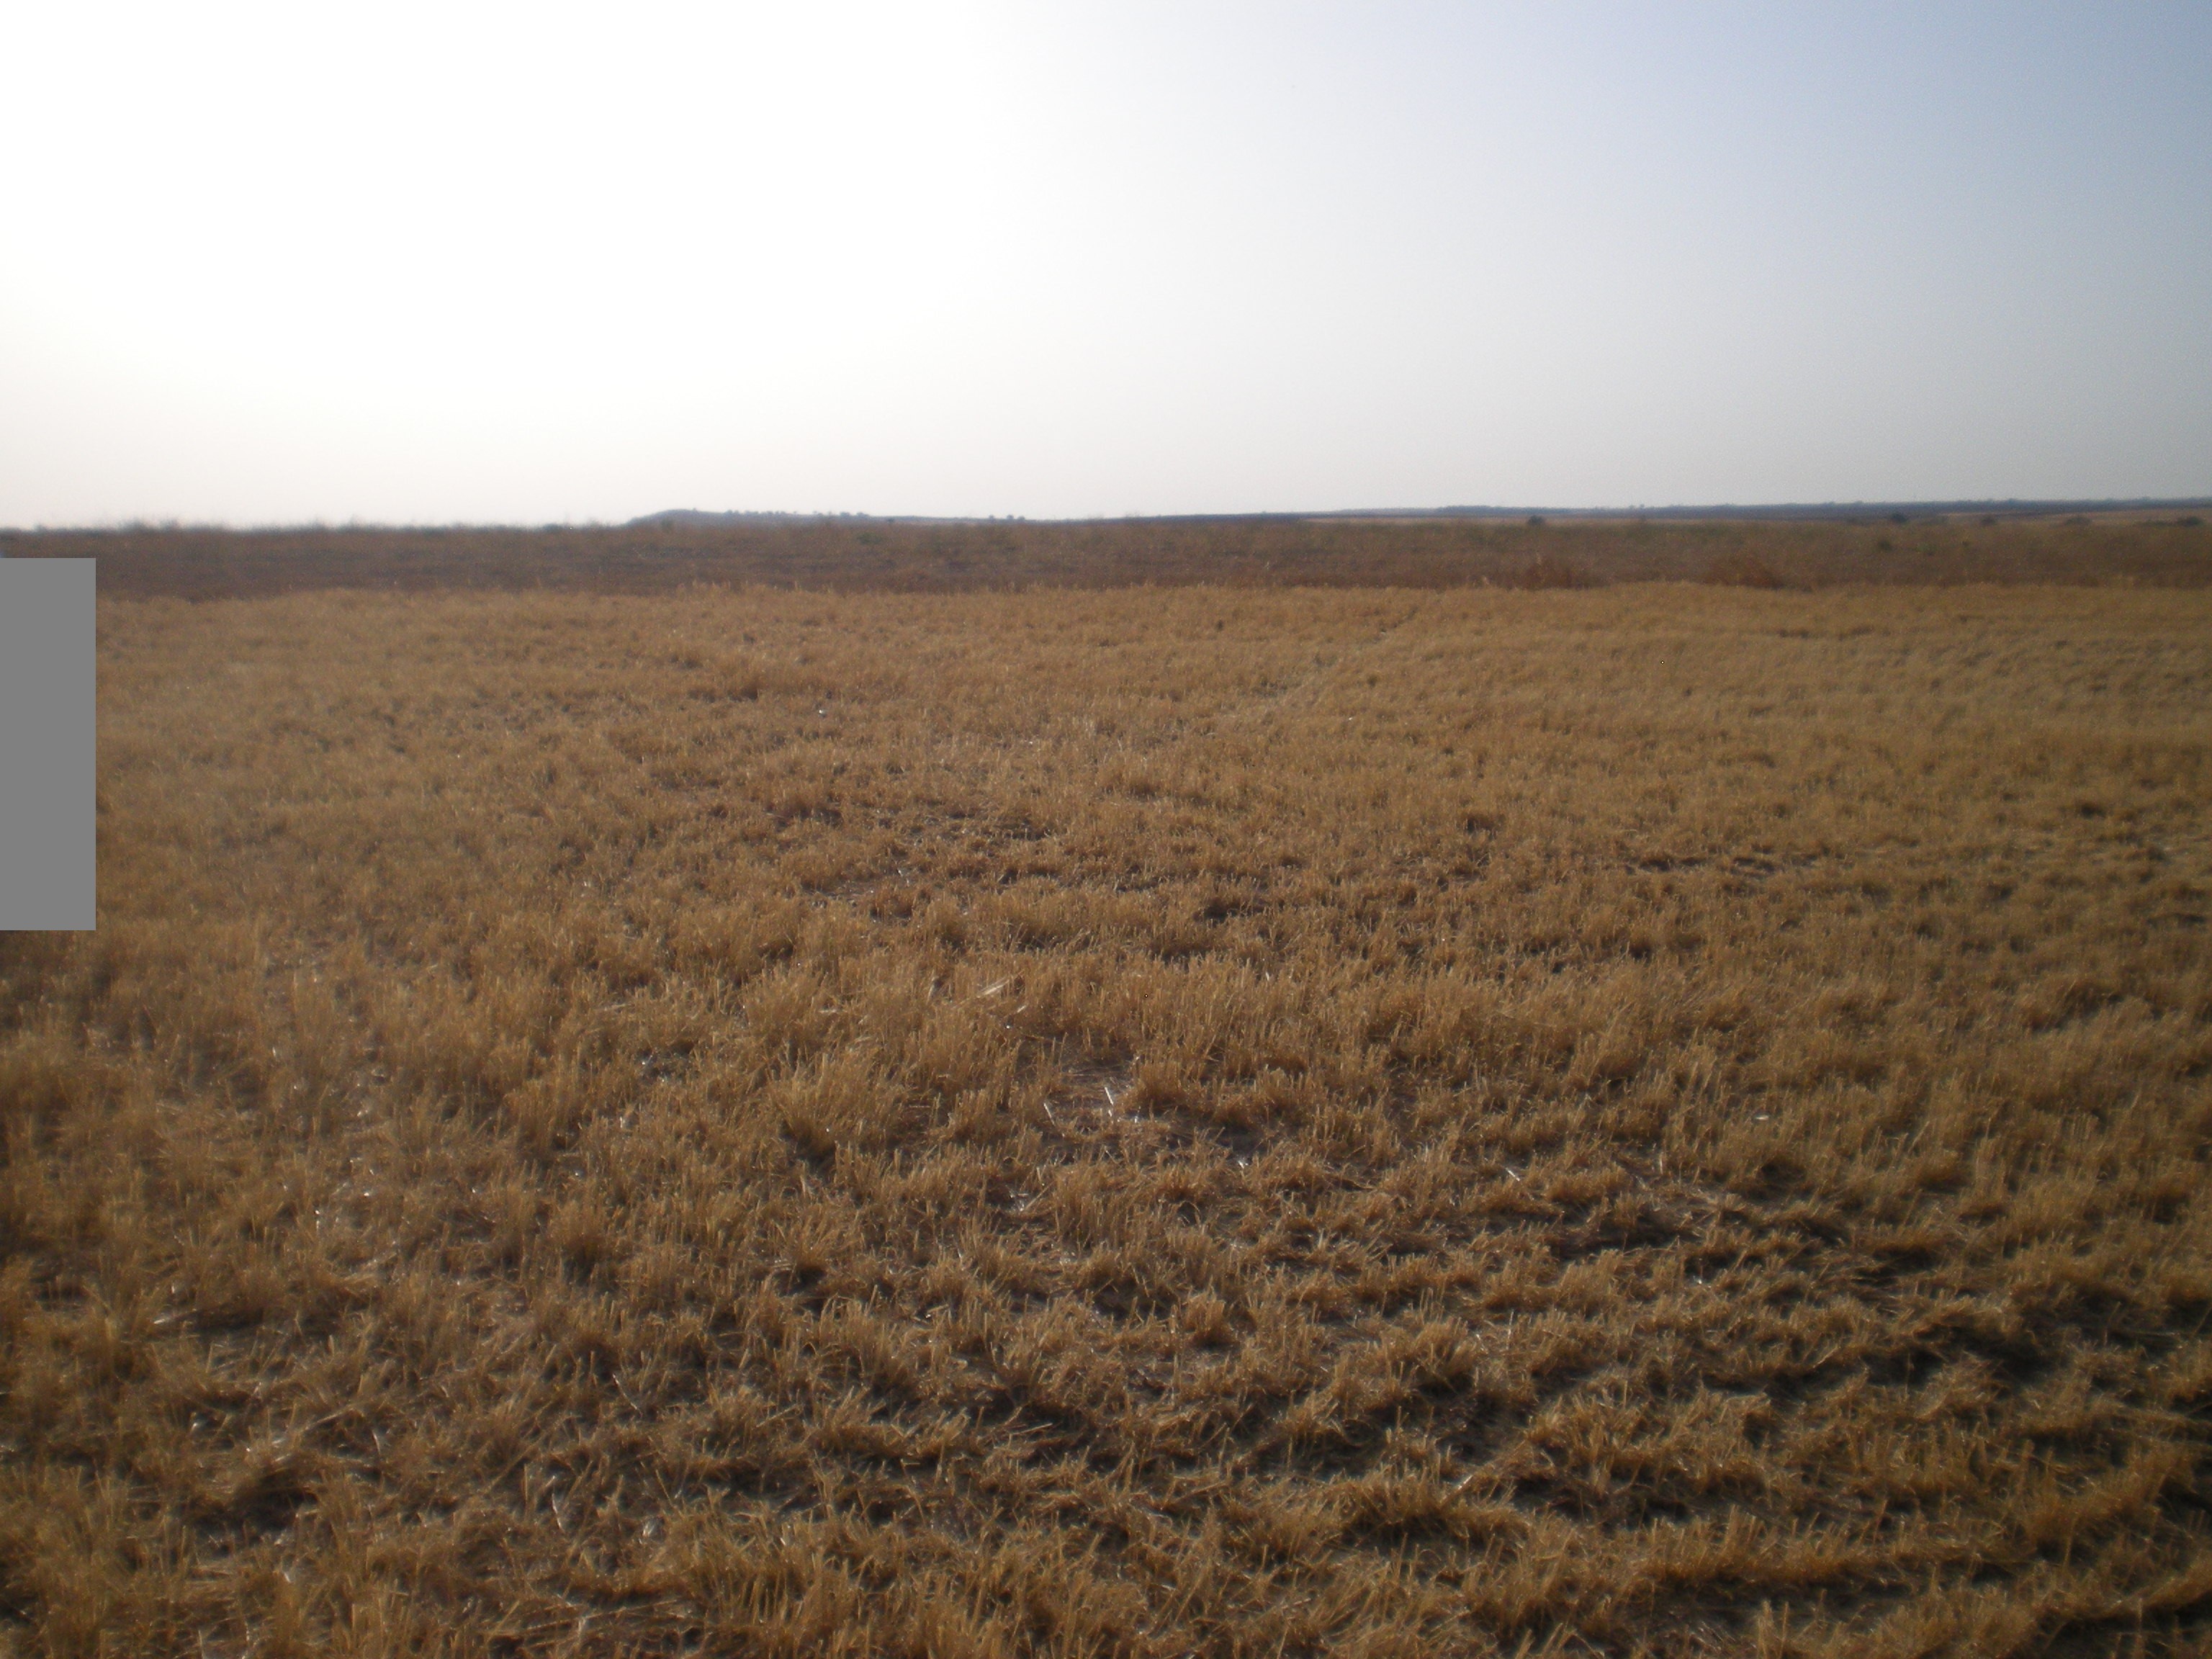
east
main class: Cropland
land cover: Barley
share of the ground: < 10 %
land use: Agriculture (excluding fallow land and kitchen gardens)
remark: Harvested field
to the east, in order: Barley; Spontaneously vegetated surfaces; Other bare soil; Grass margins; Other bare soil
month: July
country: ES
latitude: 39.4875
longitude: -3.2863
